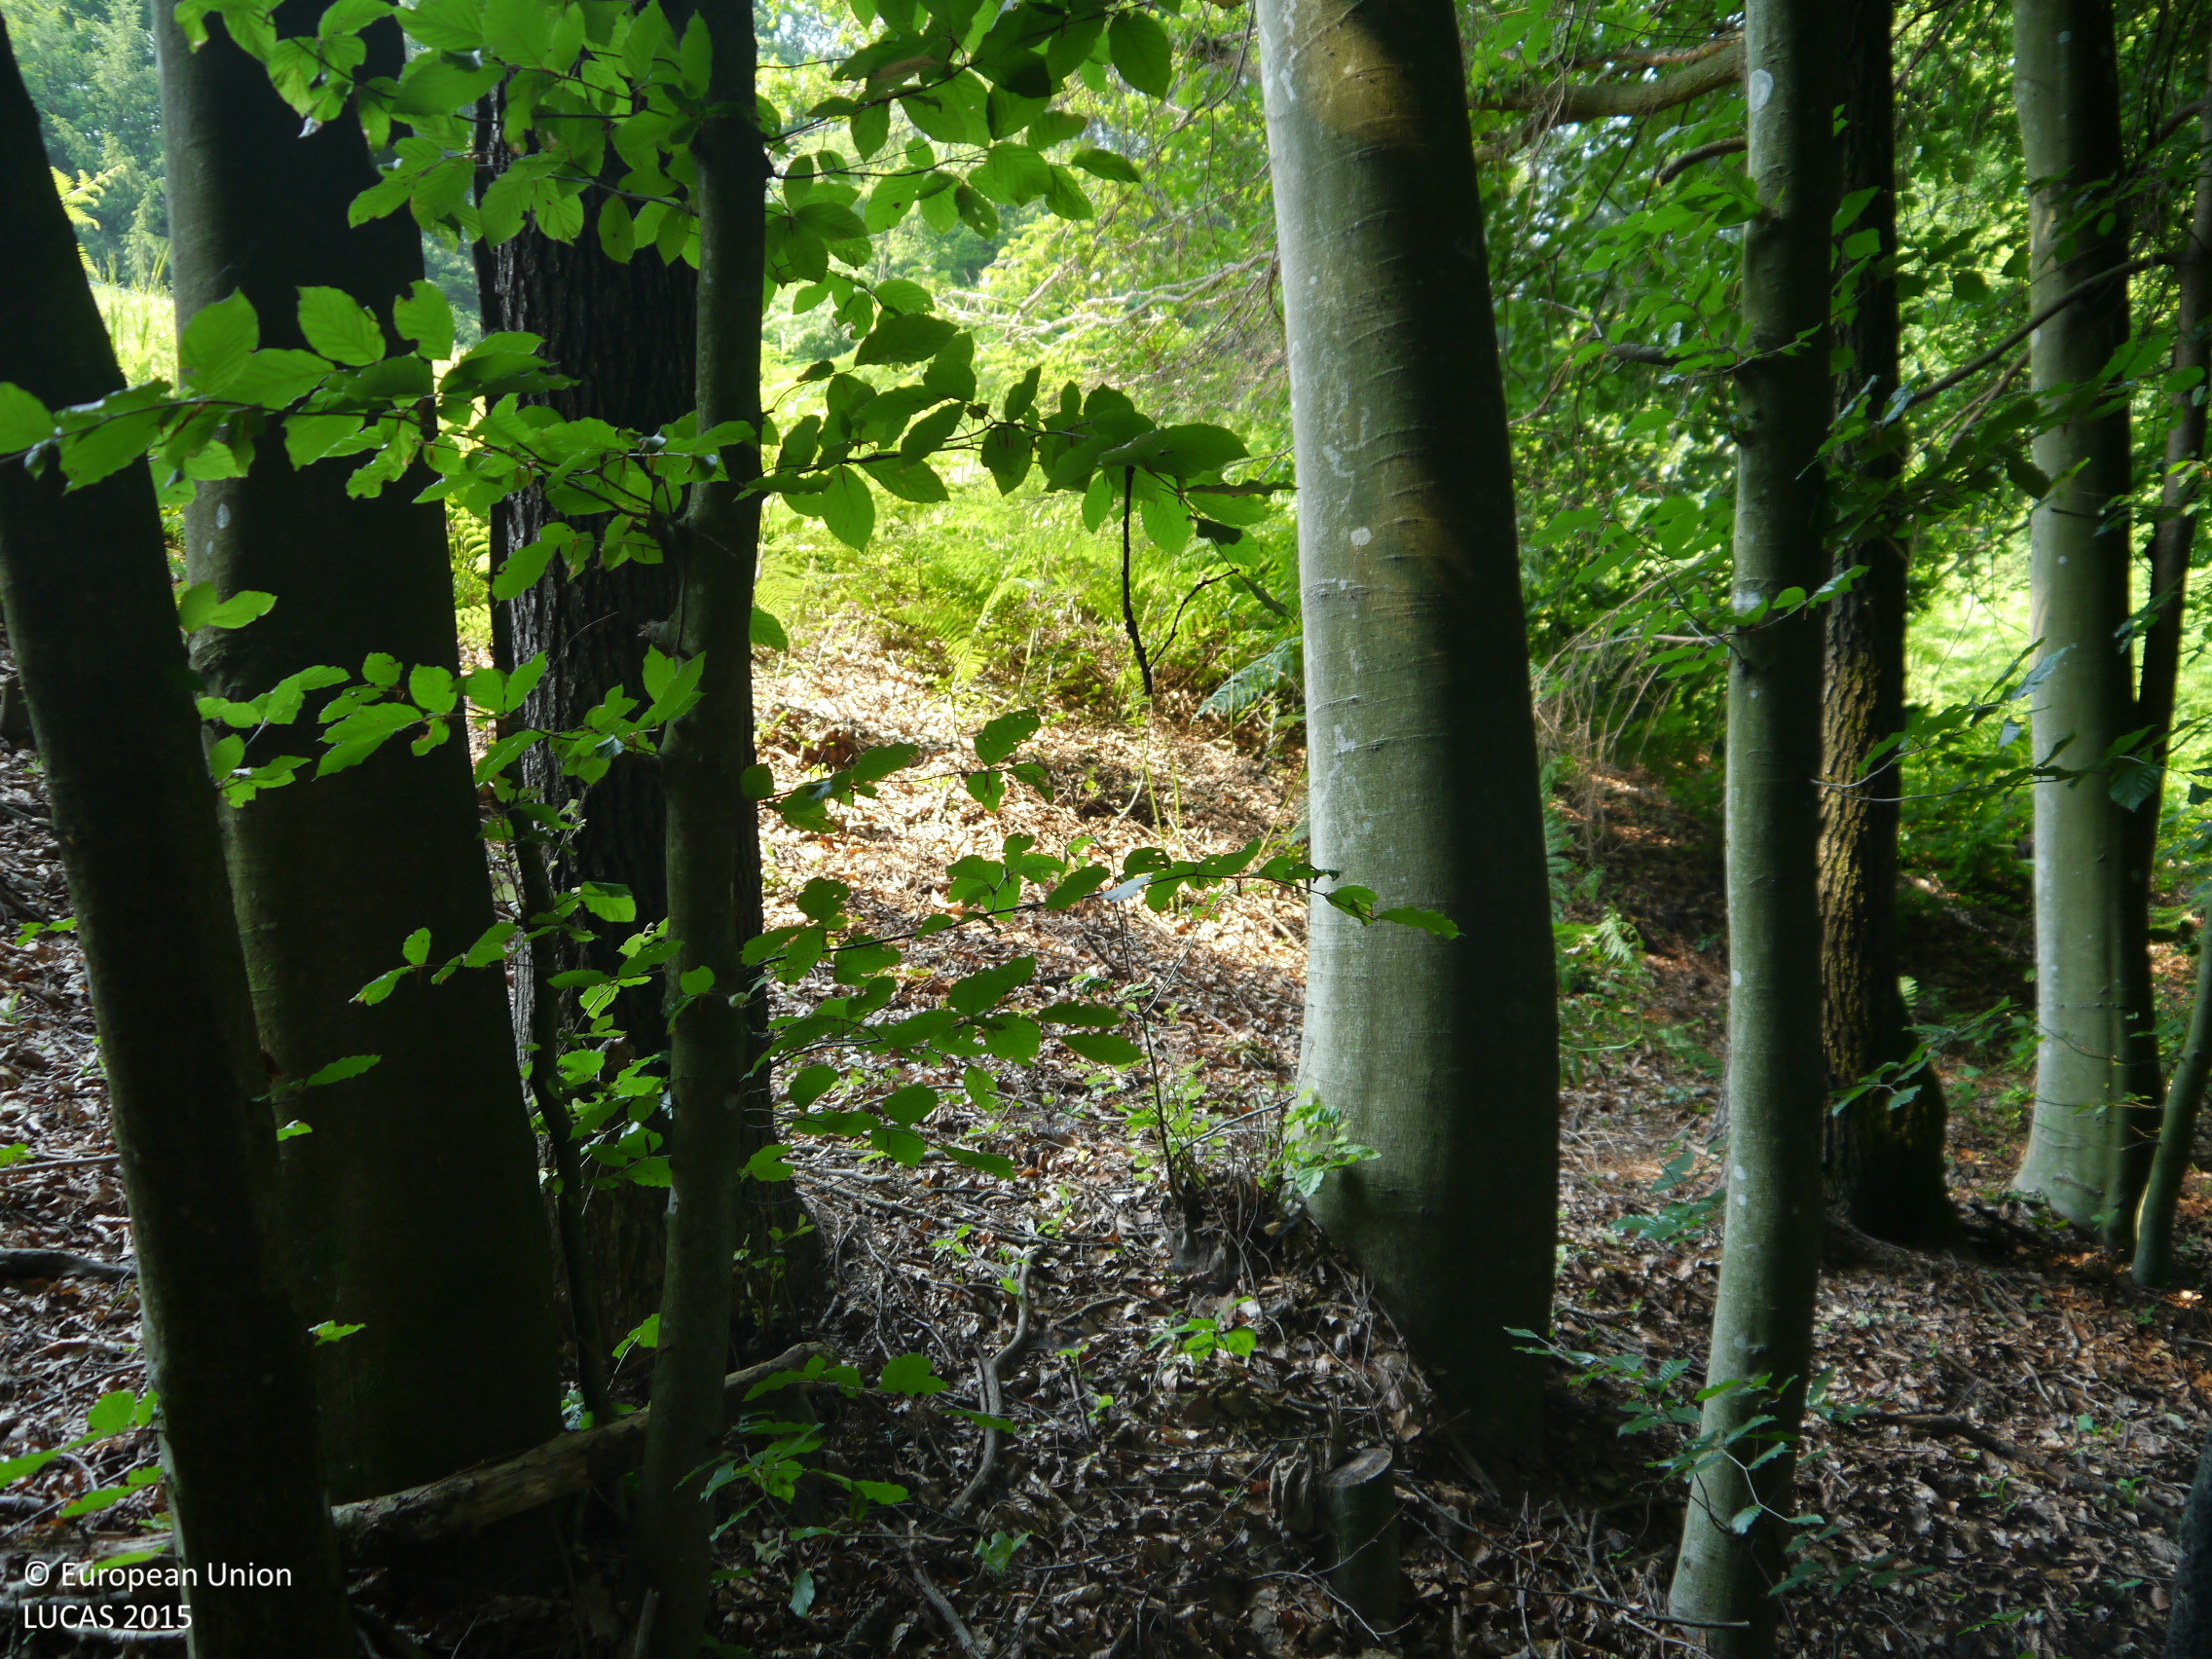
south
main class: Woodland
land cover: Broadleaved woodland
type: mountainous beech forest
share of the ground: > 75 %
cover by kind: broadleaved forest trees 90 %, coniferous forest trees 10 %
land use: Forestry
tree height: > 5 m
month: June
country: AT
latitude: 46.7817
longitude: 15.2512
